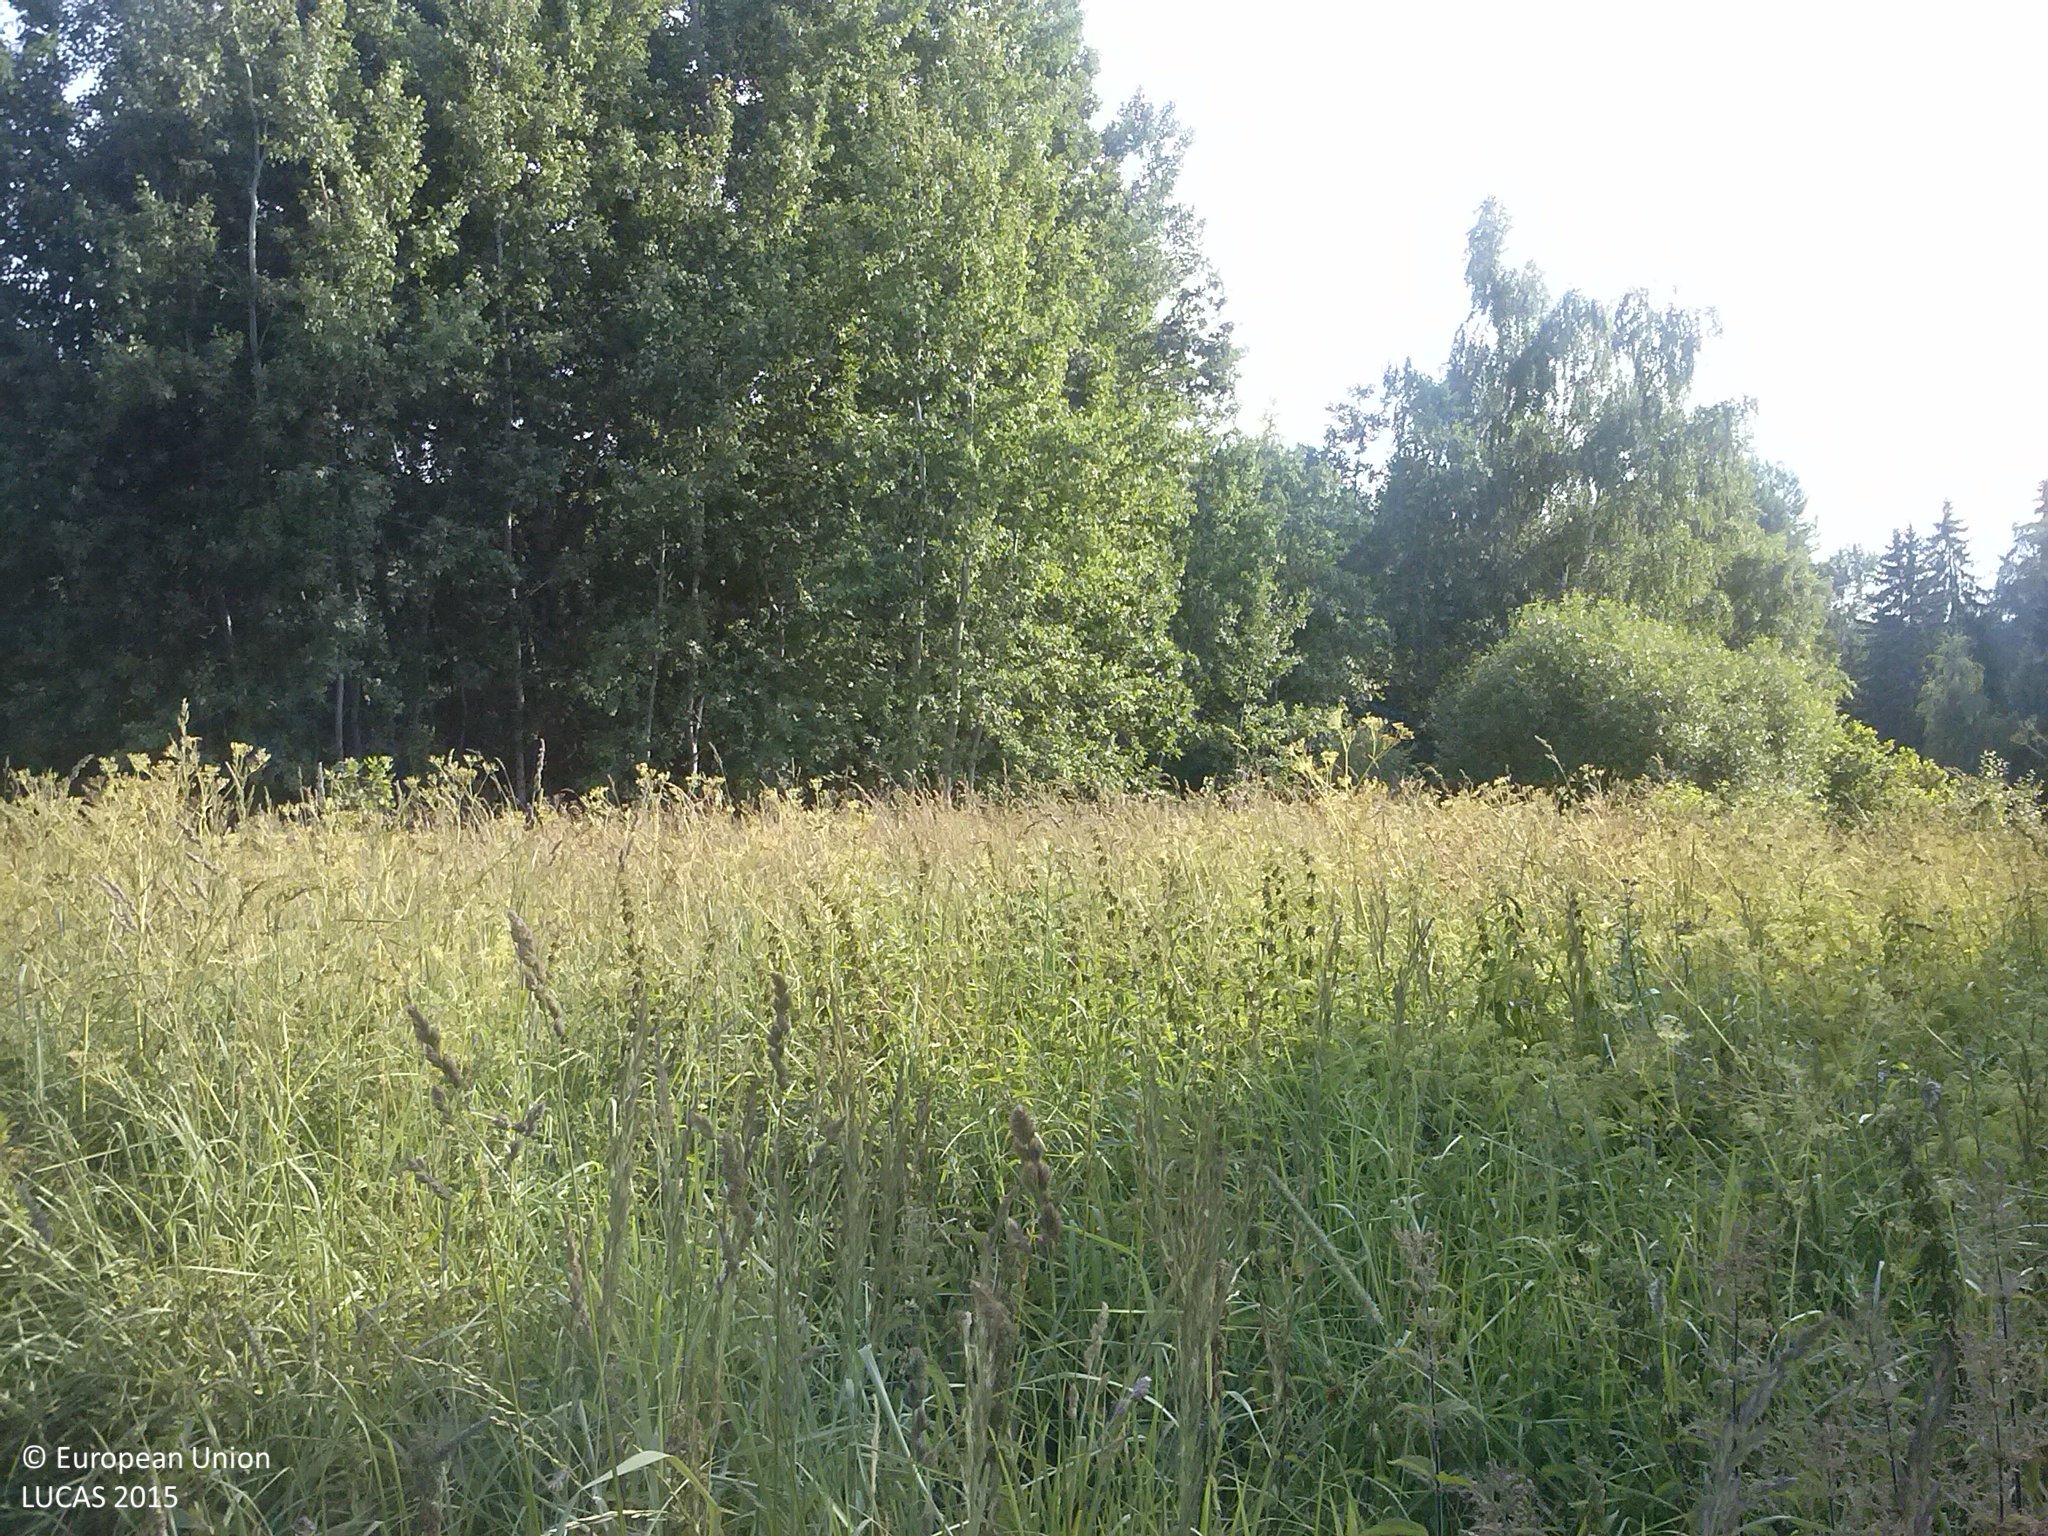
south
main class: Grassland
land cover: Spontaneously vegetated surfaces
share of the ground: > 75 %
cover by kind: herbaceous plants 100 %
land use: Semi-natural and natural areas not in use
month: July
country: LV
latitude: 56.6655
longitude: 27.3887
